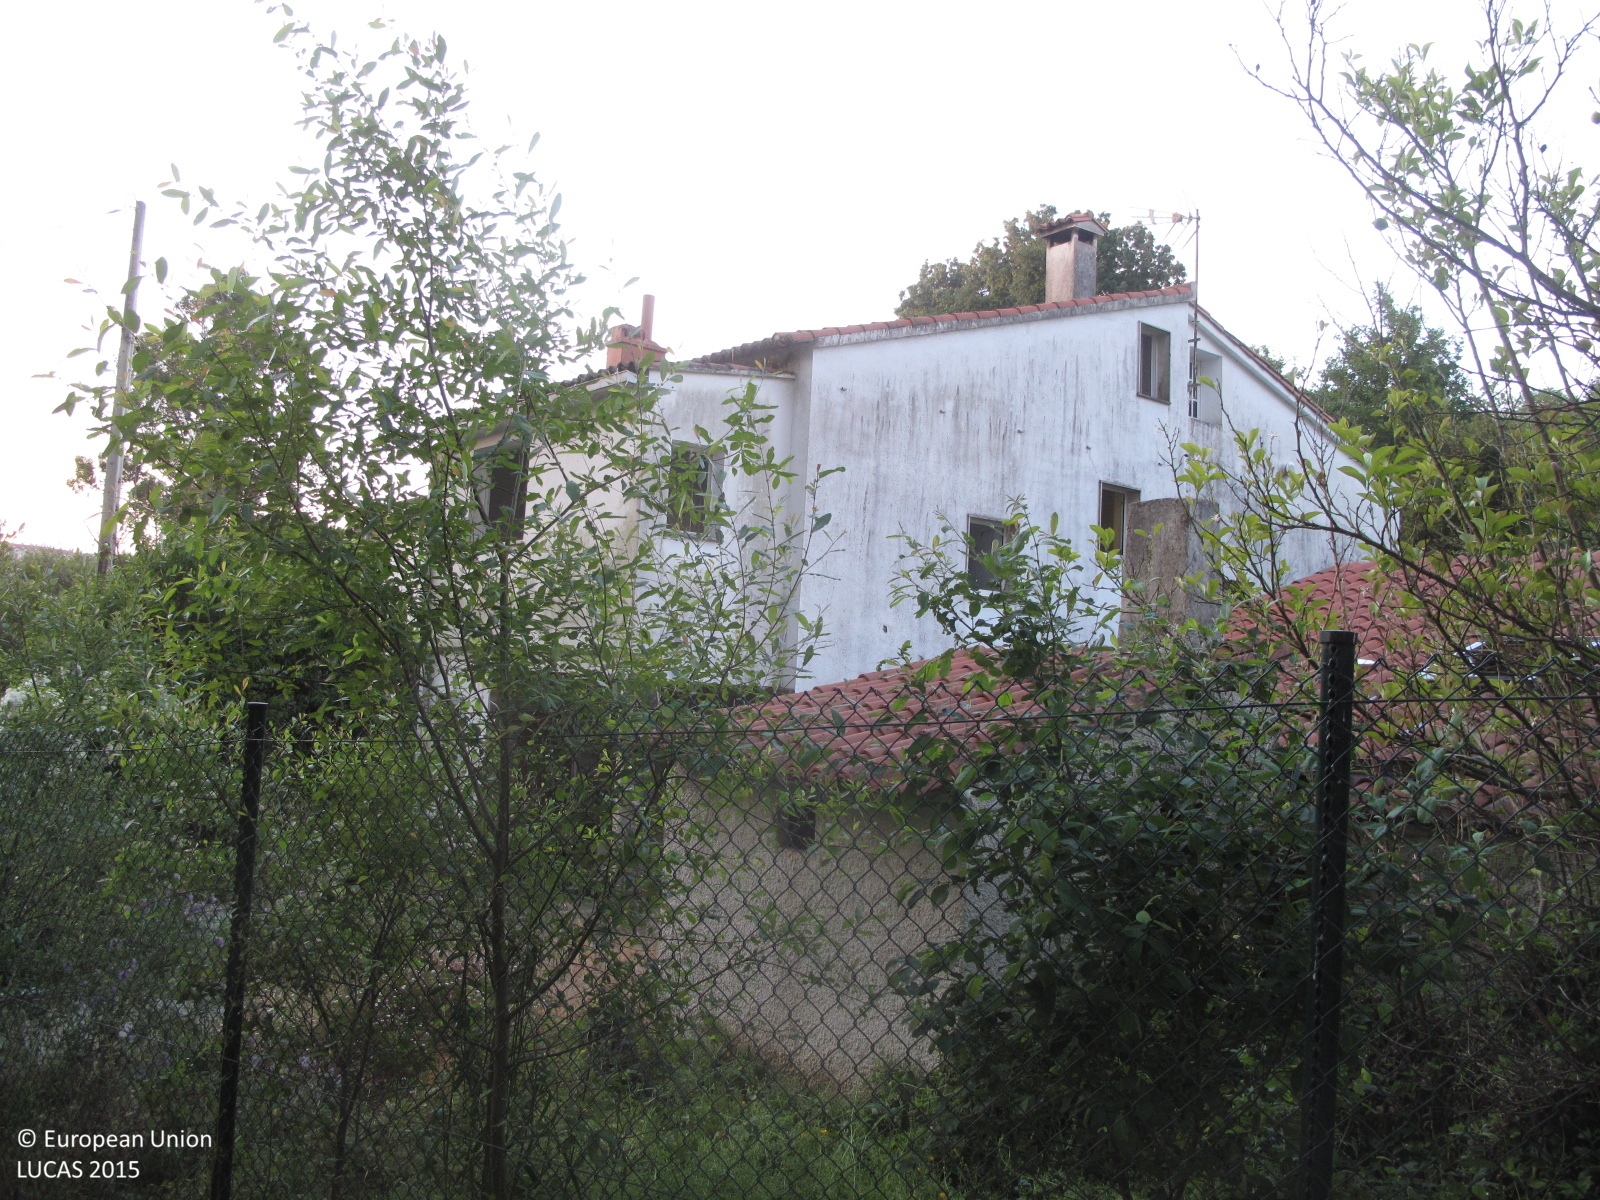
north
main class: Cropland
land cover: Other citrus fruit
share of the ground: 25 - 50 %
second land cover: Spontaneously vegetated surfaces
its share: 25 - 50 %
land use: Kitchen garden
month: June
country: ES
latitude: 42.8630
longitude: -8.5498
